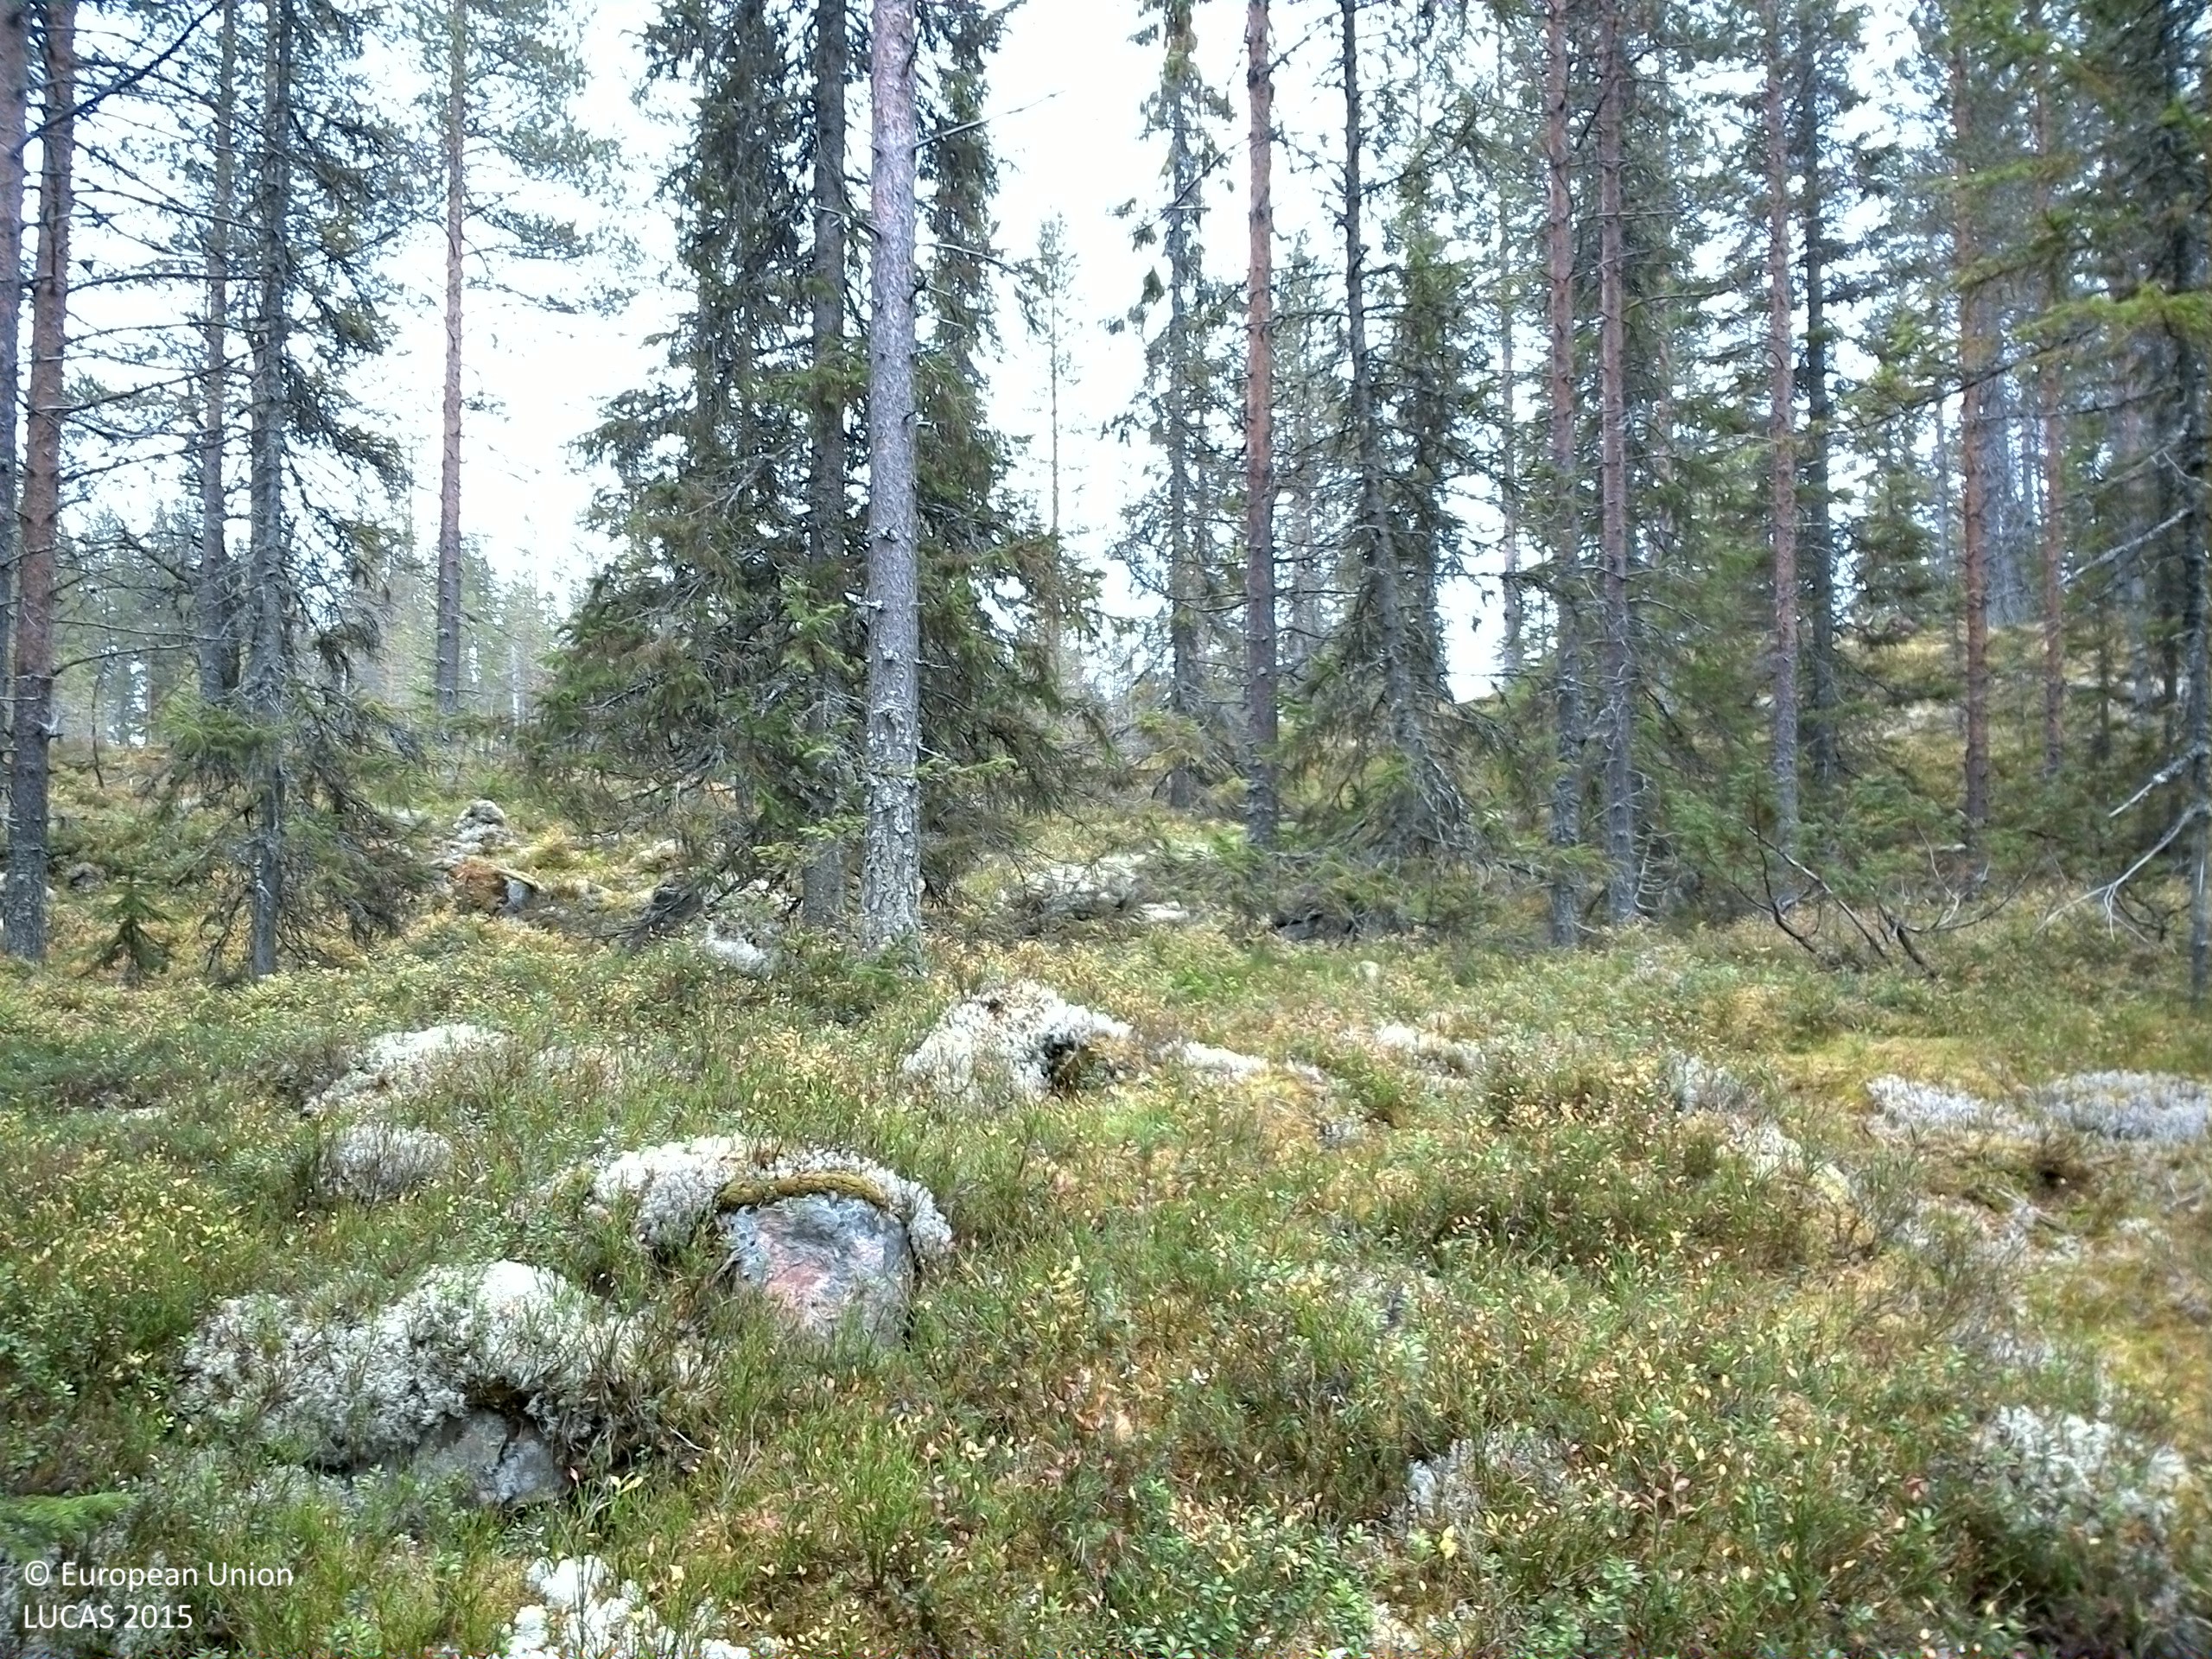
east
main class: Woodland
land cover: Spruce dominated coniferous woodland
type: boreal forest
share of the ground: 25 - 50 %
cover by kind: coniferous forest trees 45 %, shrubs 30 %, lichens and mosses 15 %, consolidated bare surface 10 %
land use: Forestry
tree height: > 5 m
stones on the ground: 10 - 25 %
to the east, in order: Spruce dominated coniferous woodland; Pine dominated coniferous woodland
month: October
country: SE
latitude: 61.5370
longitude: 14.4053
